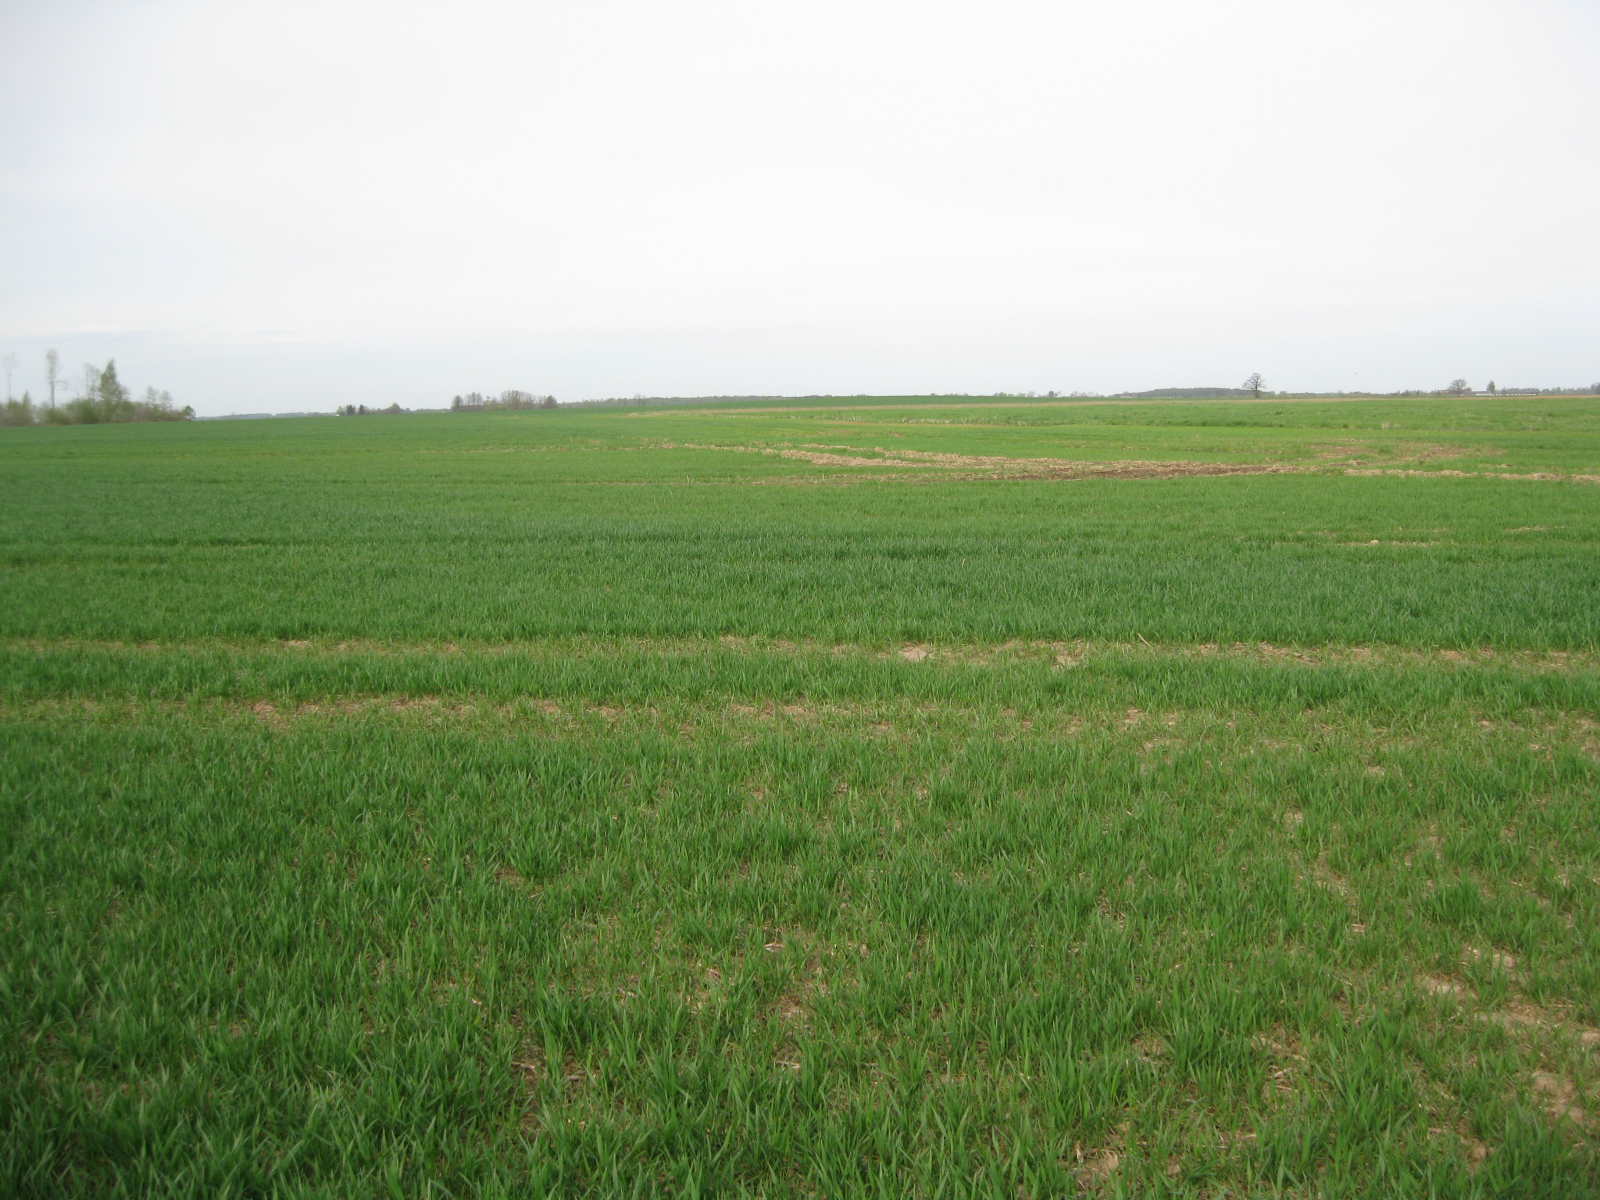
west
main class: Cropland
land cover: Common wheat
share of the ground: > 75 %
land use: Agriculture (excluding fallow land and kitchen gardens)
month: May
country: LT
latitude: 56.2572
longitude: 24.4793
